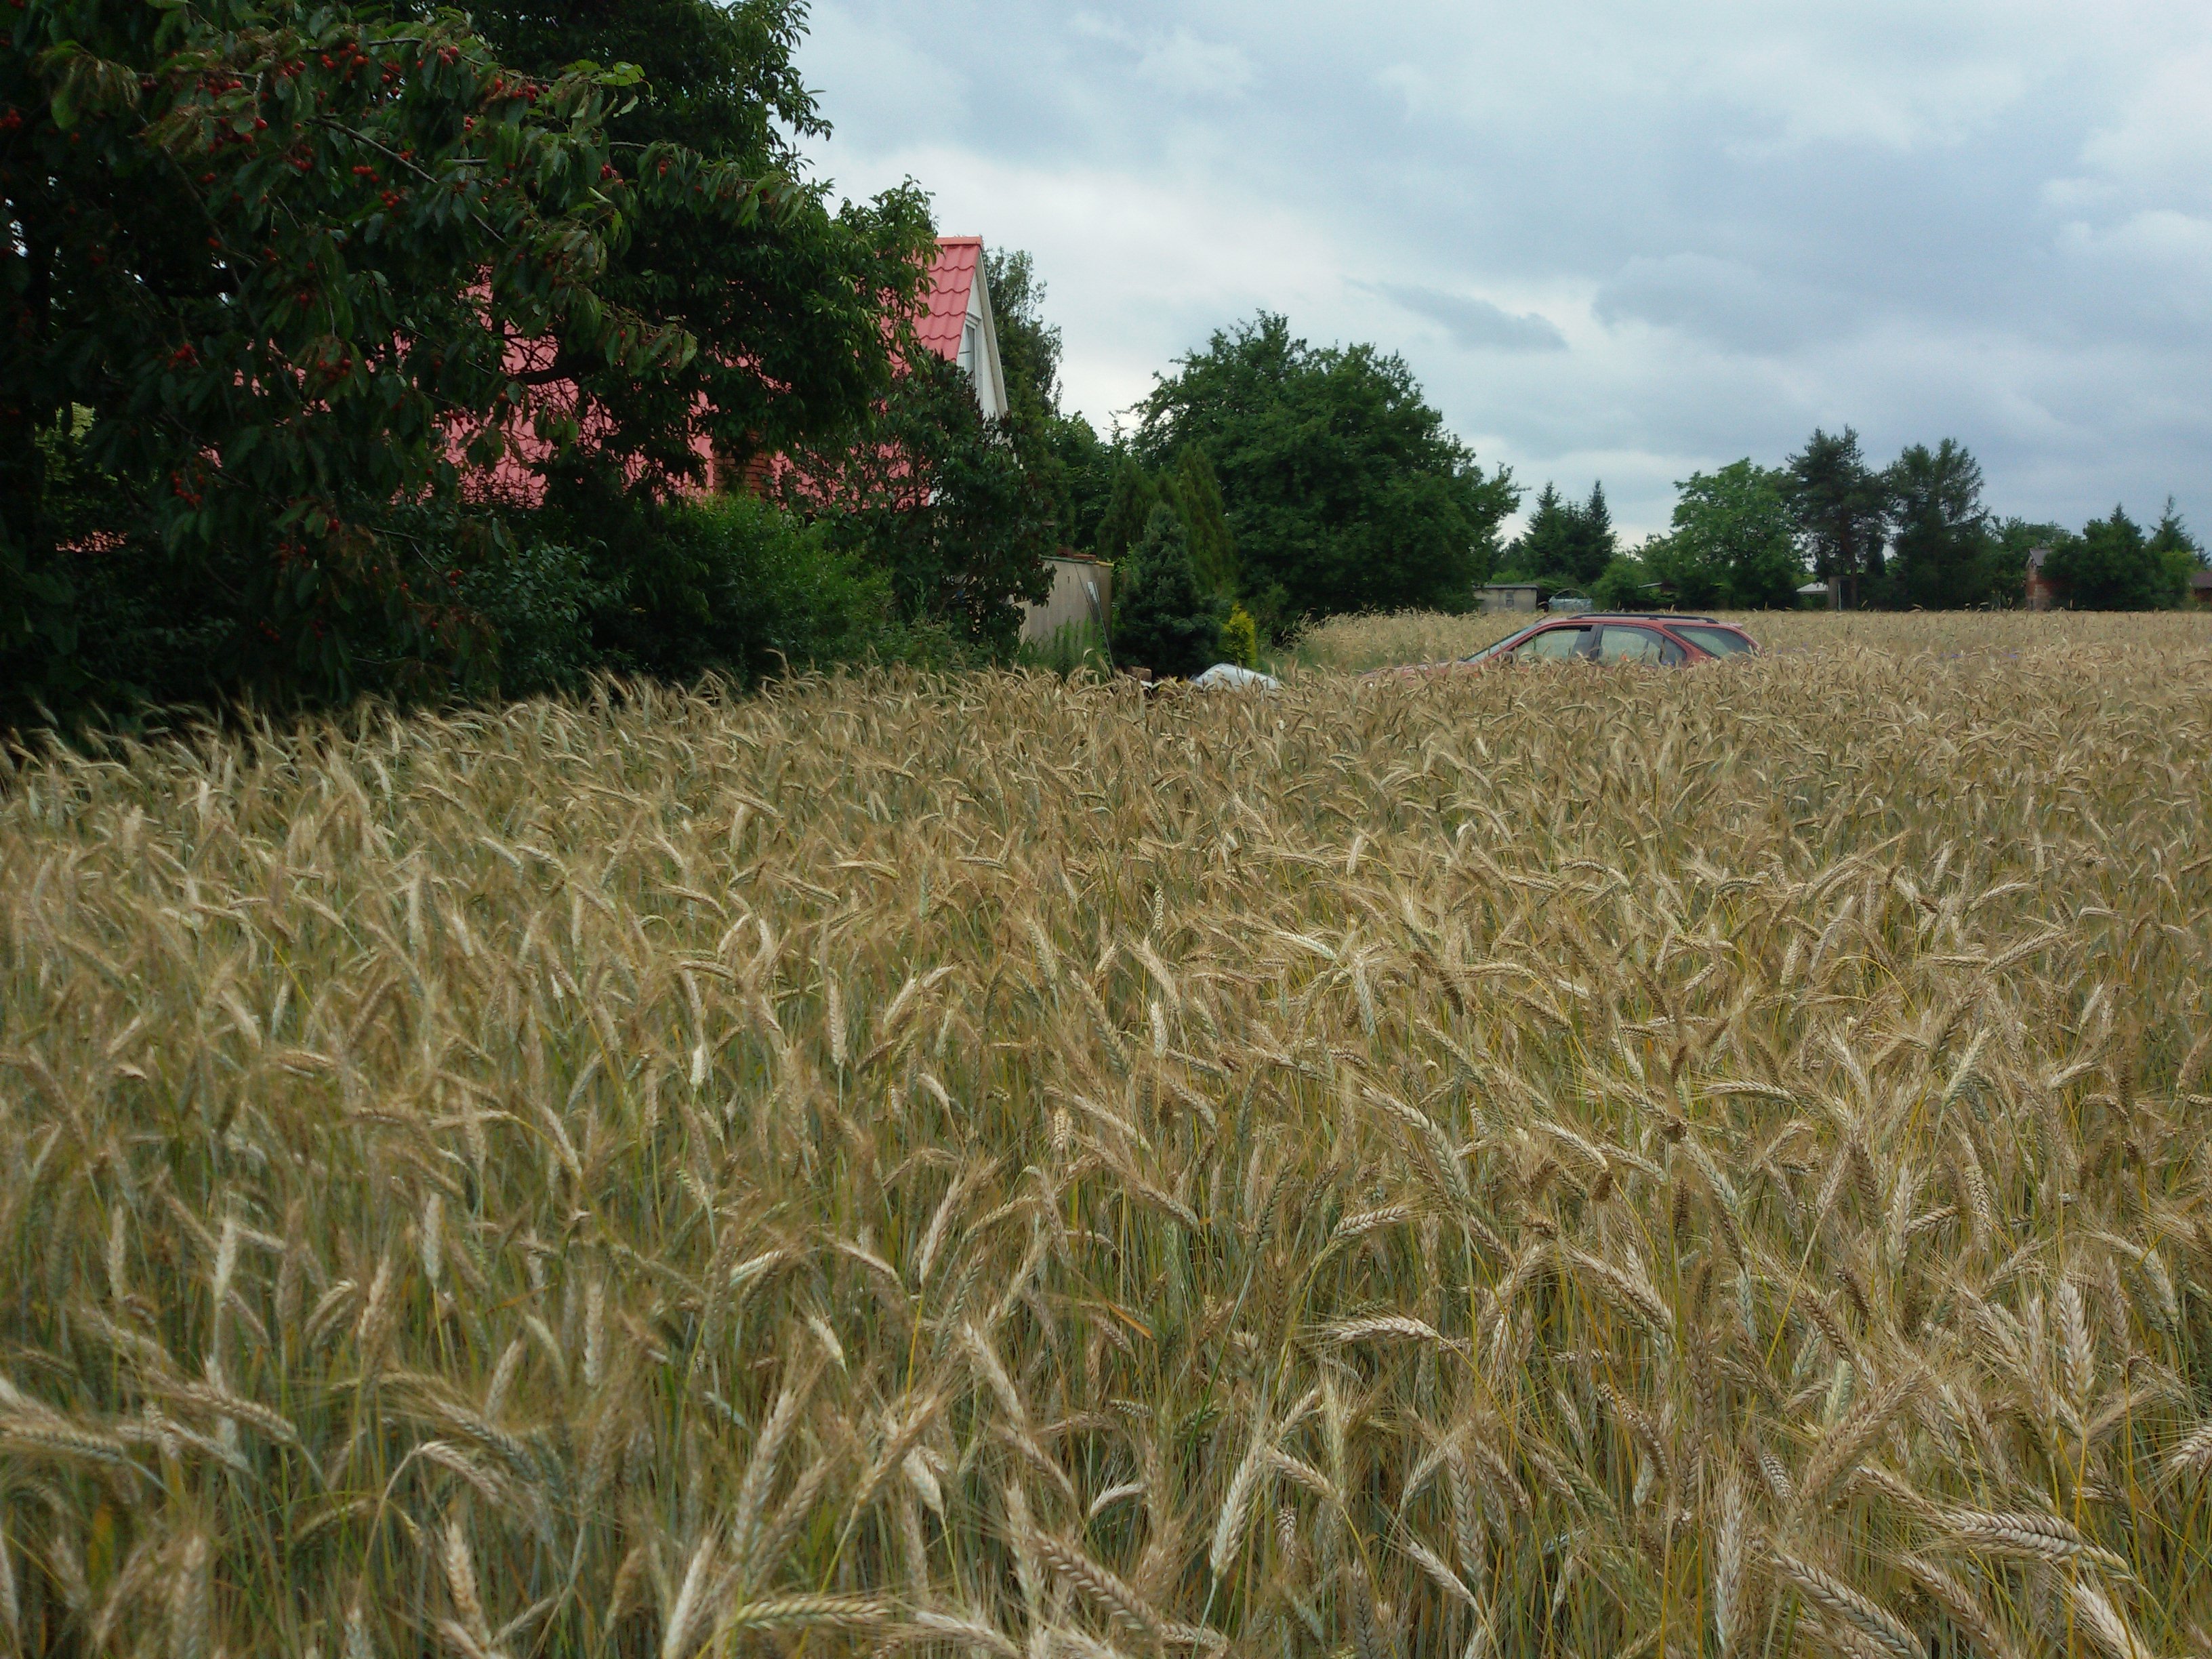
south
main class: Cropland
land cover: Triticale
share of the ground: > 75 %
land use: Agriculture (excluding fallow land and kitchen gardens)
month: July
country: PL
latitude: 52.3165
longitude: 16.9778
